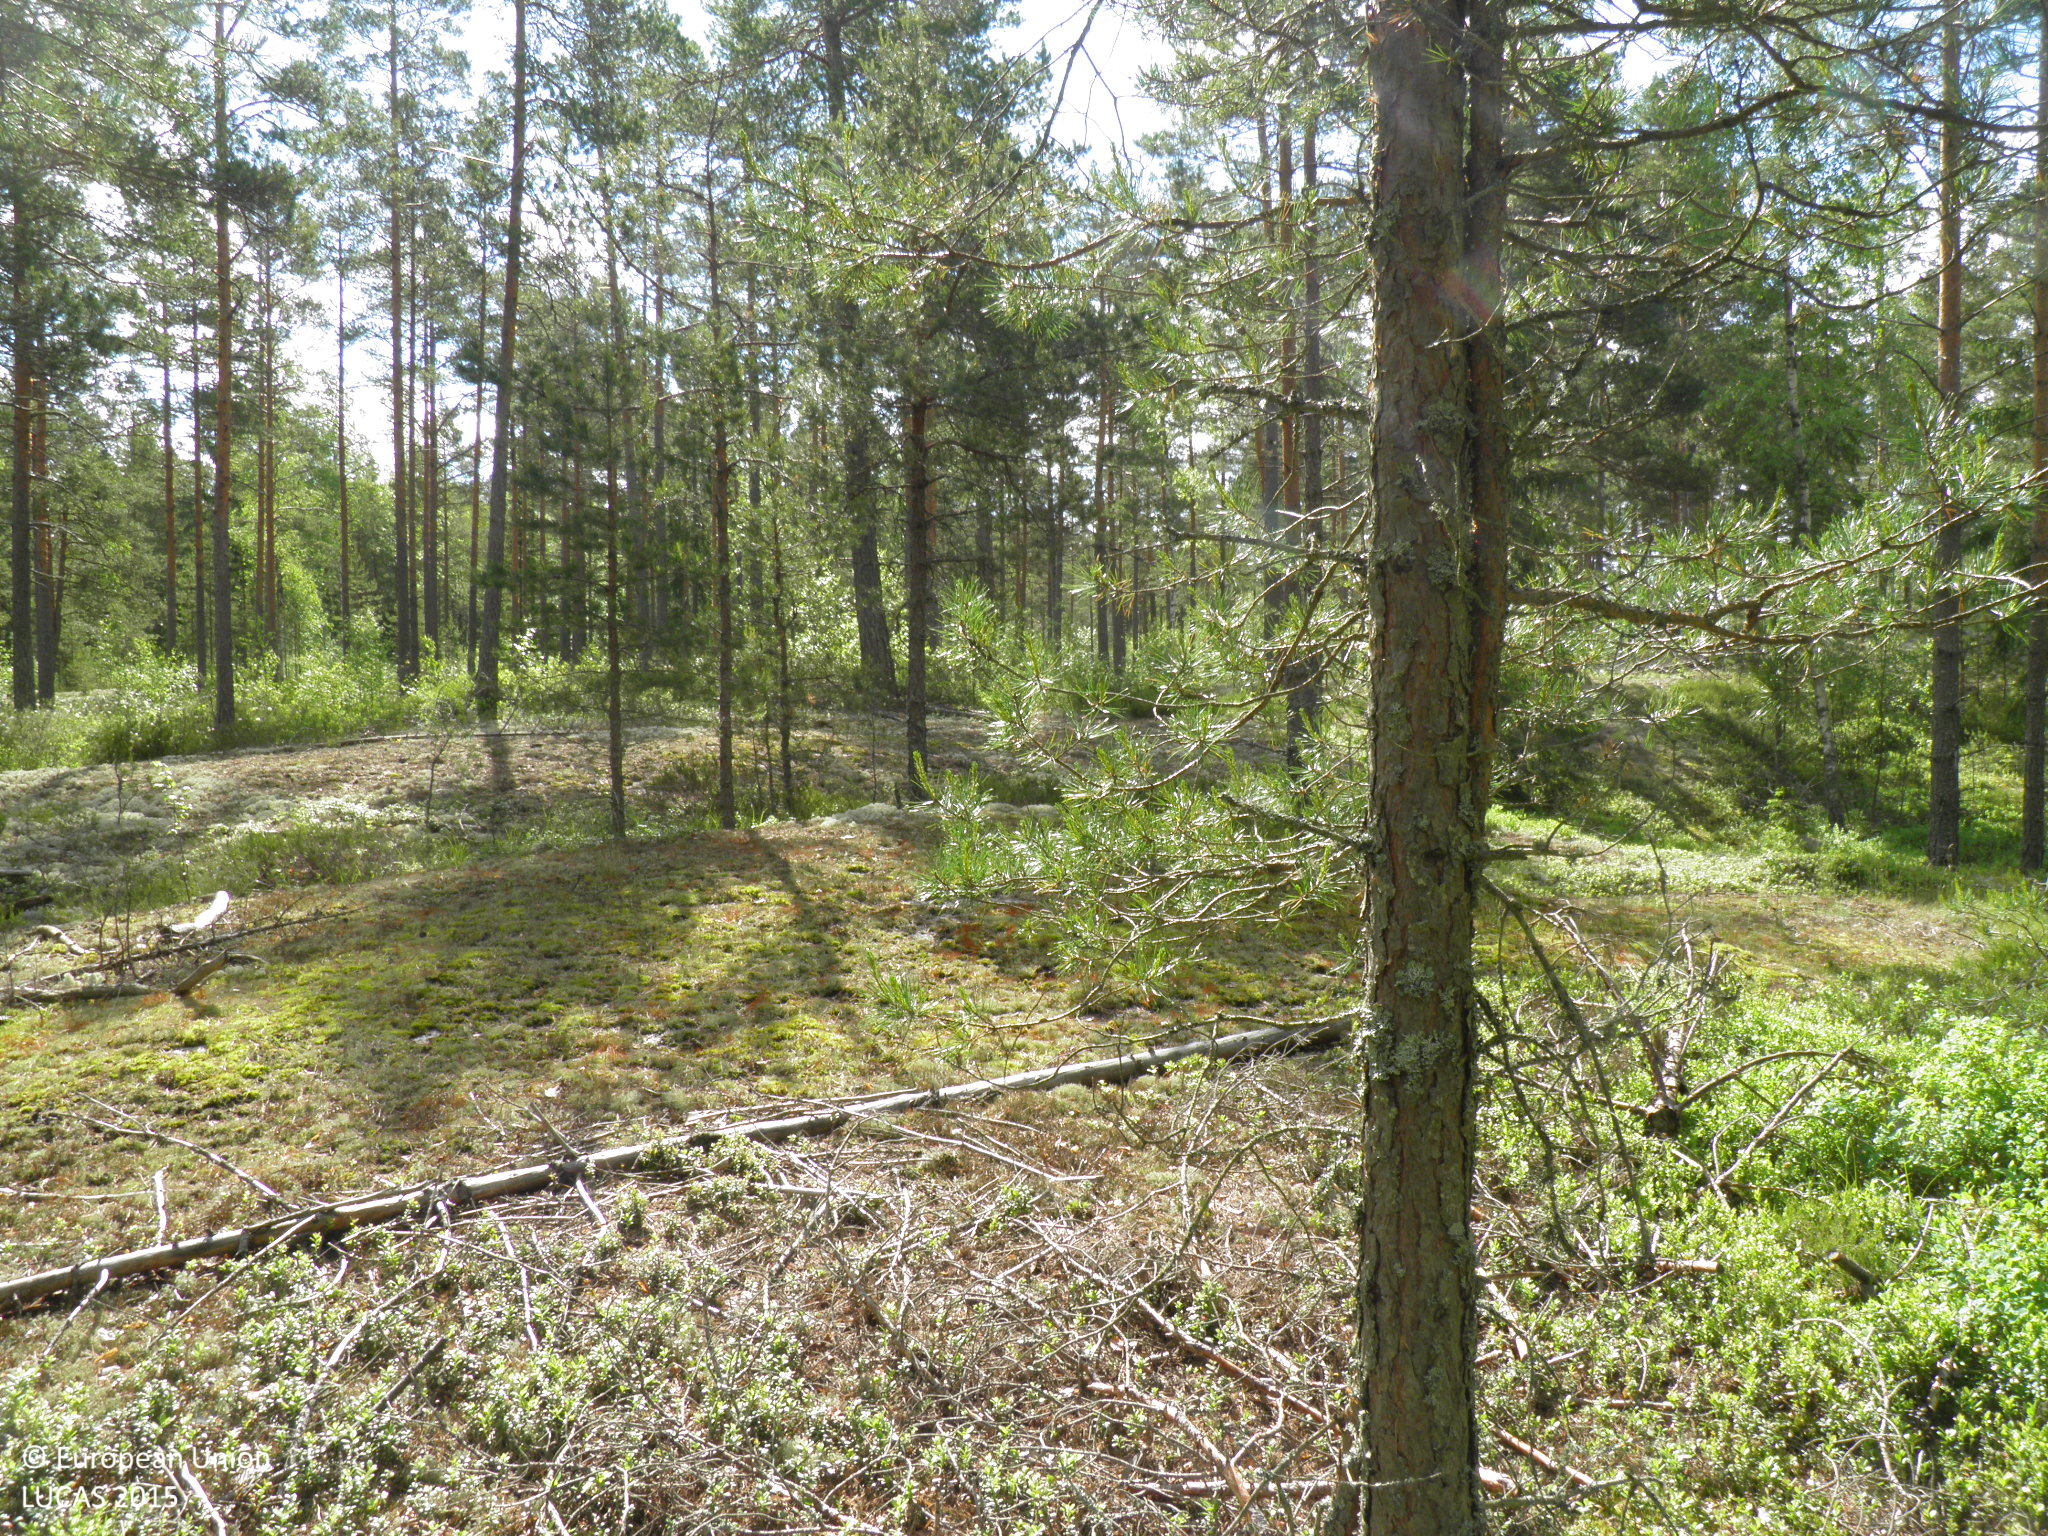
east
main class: Woodland
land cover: Pine dominated coniferous woodland
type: hemiboreal forest and nemoral coniferous forest and mixed broadleaved-coniferous forest
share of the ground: > 75 %
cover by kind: coniferous forest trees 70 %, shrubs 15 %, lichens and mosses 10 %, broadleaved forest trees 5 %
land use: Forestry
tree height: > 5 m
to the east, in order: Pine dominated coniferous woodland; Lichens and moss; Pine dominated coniferous woodland
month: June
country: FI
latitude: 60.3441
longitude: 22.5926
